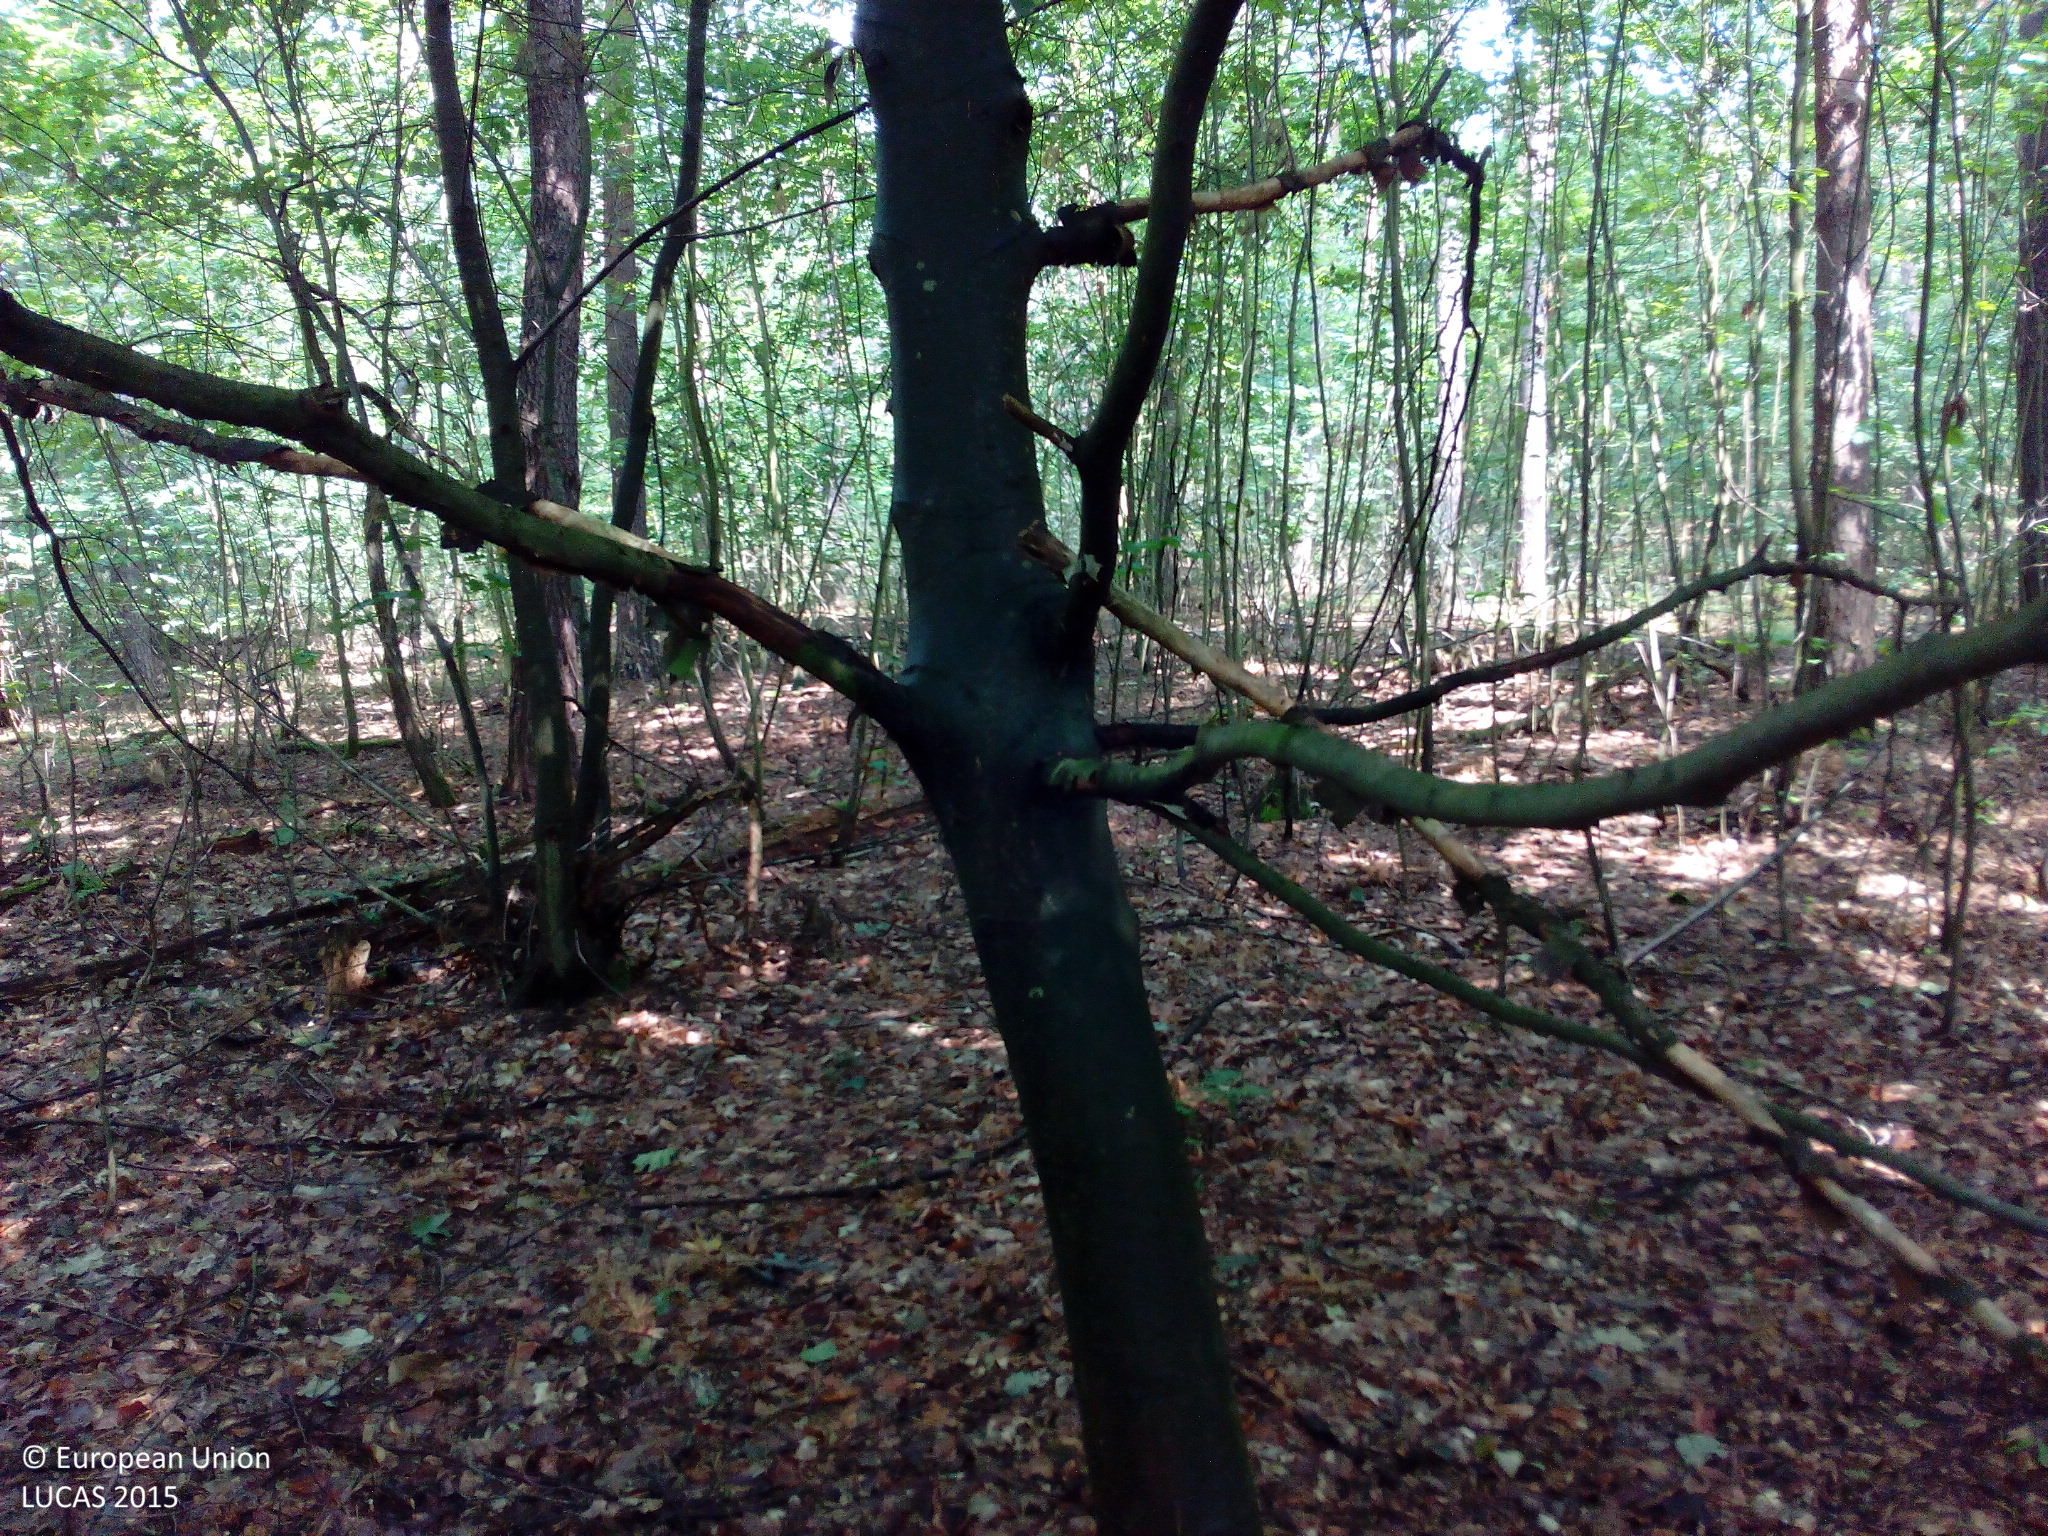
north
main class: Woodland
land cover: Pine dominated mixed woodland
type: hemiboreal forest and nemoral coniferous forest and mixed broadleaved-coniferous forest
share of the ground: > 75 %
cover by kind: coniferous forest trees 70 %, broadleaved forest trees 30 %
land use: Forestry
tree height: > 5 m
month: July
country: DE
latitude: 52.4605
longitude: 13.1937
